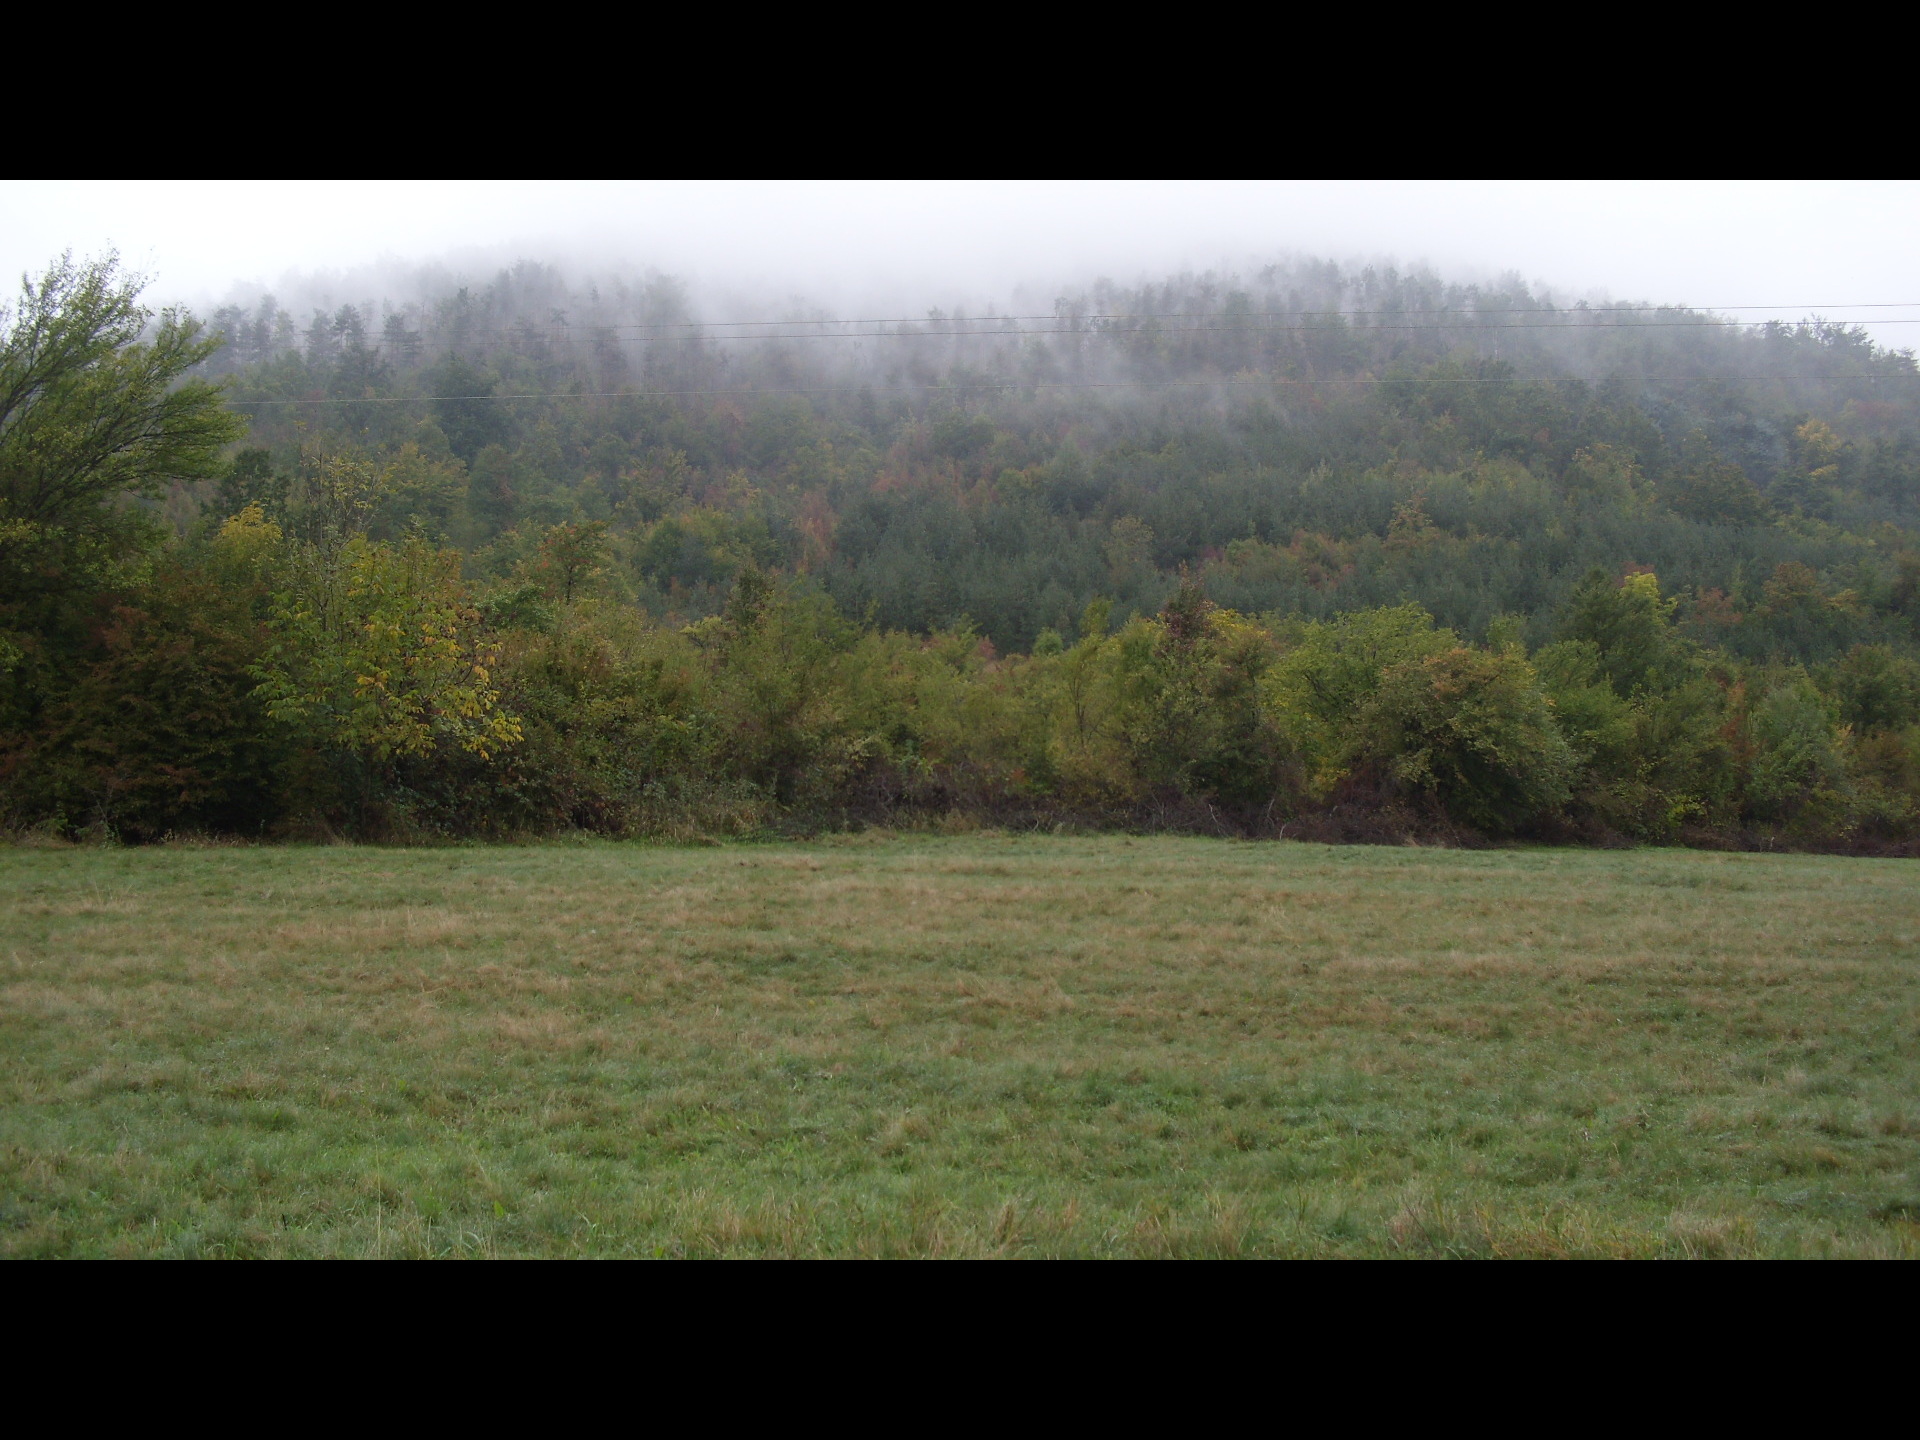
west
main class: Grassland
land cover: Grassland without tree/shrub cover
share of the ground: > 75 %
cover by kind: herbaceous plants 100 %
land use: Agriculture (excluding fallow land and kitchen gardens)
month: October
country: BG
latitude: 43.4542
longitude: 22.7248
